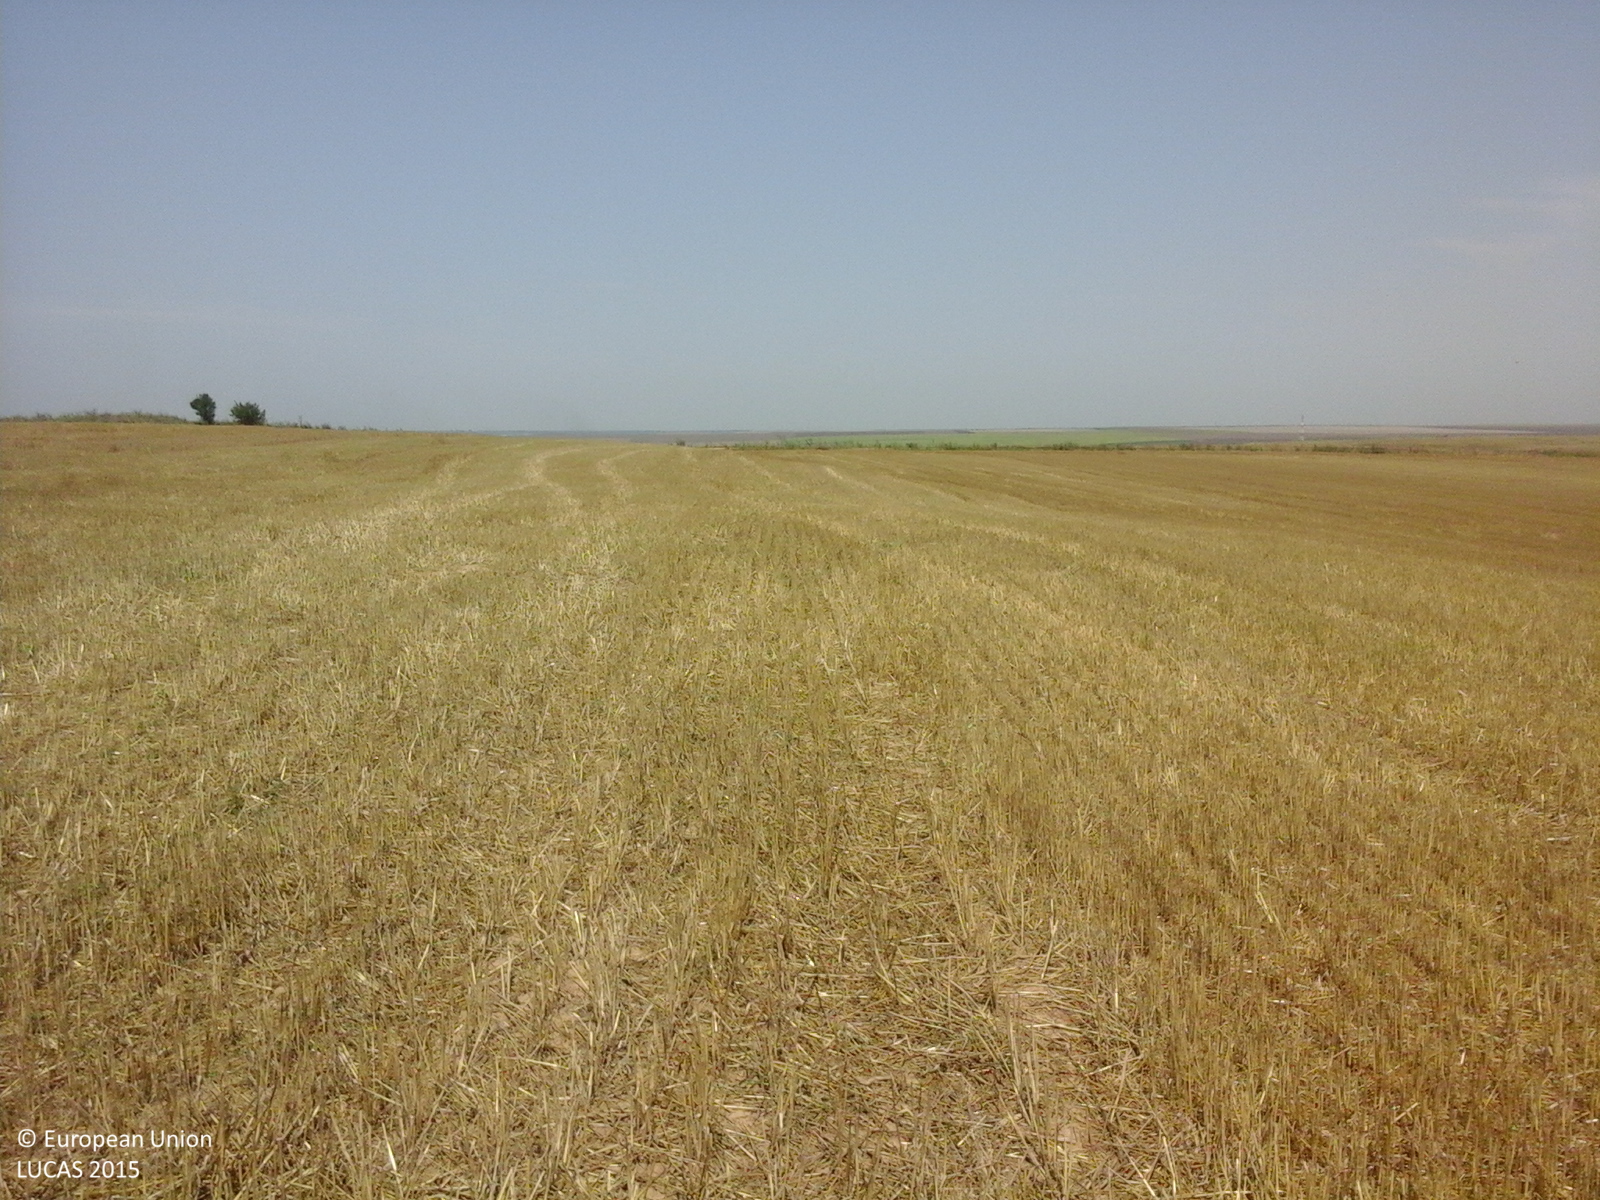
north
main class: Cropland
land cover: Common wheat
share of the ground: > 75 %
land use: Agriculture (excluding fallow land and kitchen gardens)
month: August
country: RO
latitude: 44.0797
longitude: 28.4616
